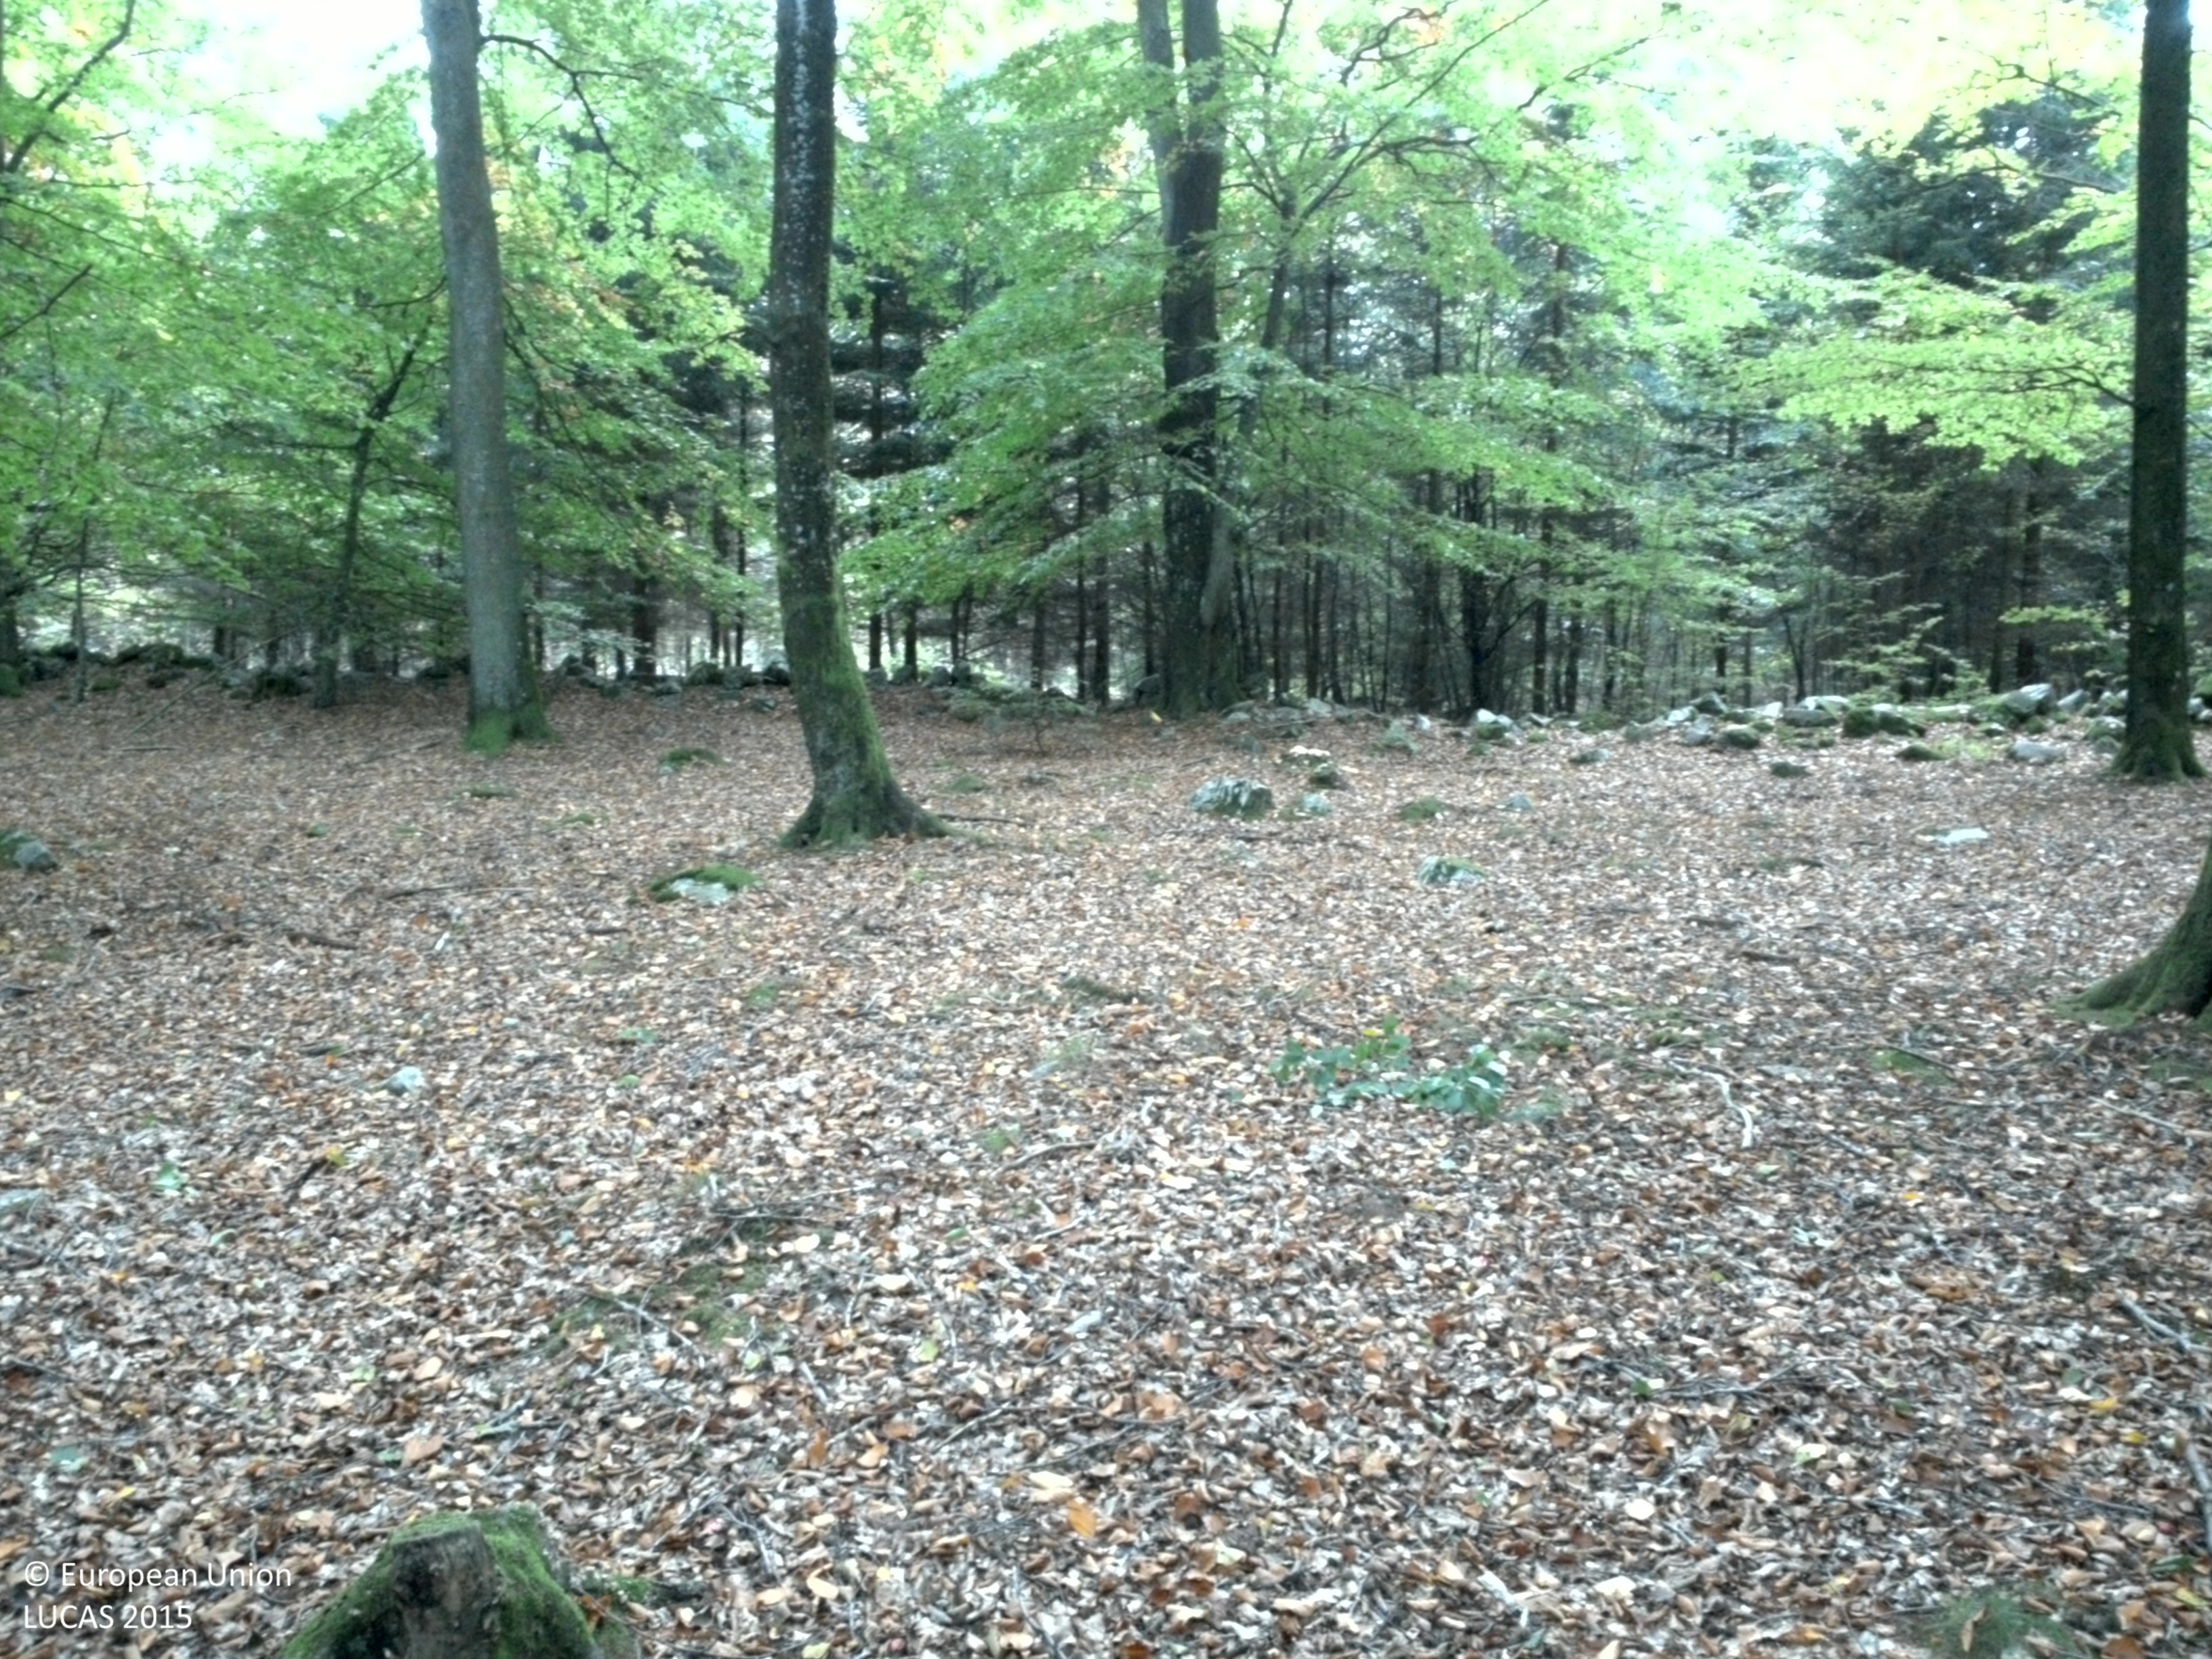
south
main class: Woodland
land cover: Broadleaved woodland
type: beech forest
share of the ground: > 75 %
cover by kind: broadleaved forest trees 90 %, unconsolidated bare surface 10 %
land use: Forestry
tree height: > 5 m
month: October
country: SE
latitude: 55.5979
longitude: 14.1724
